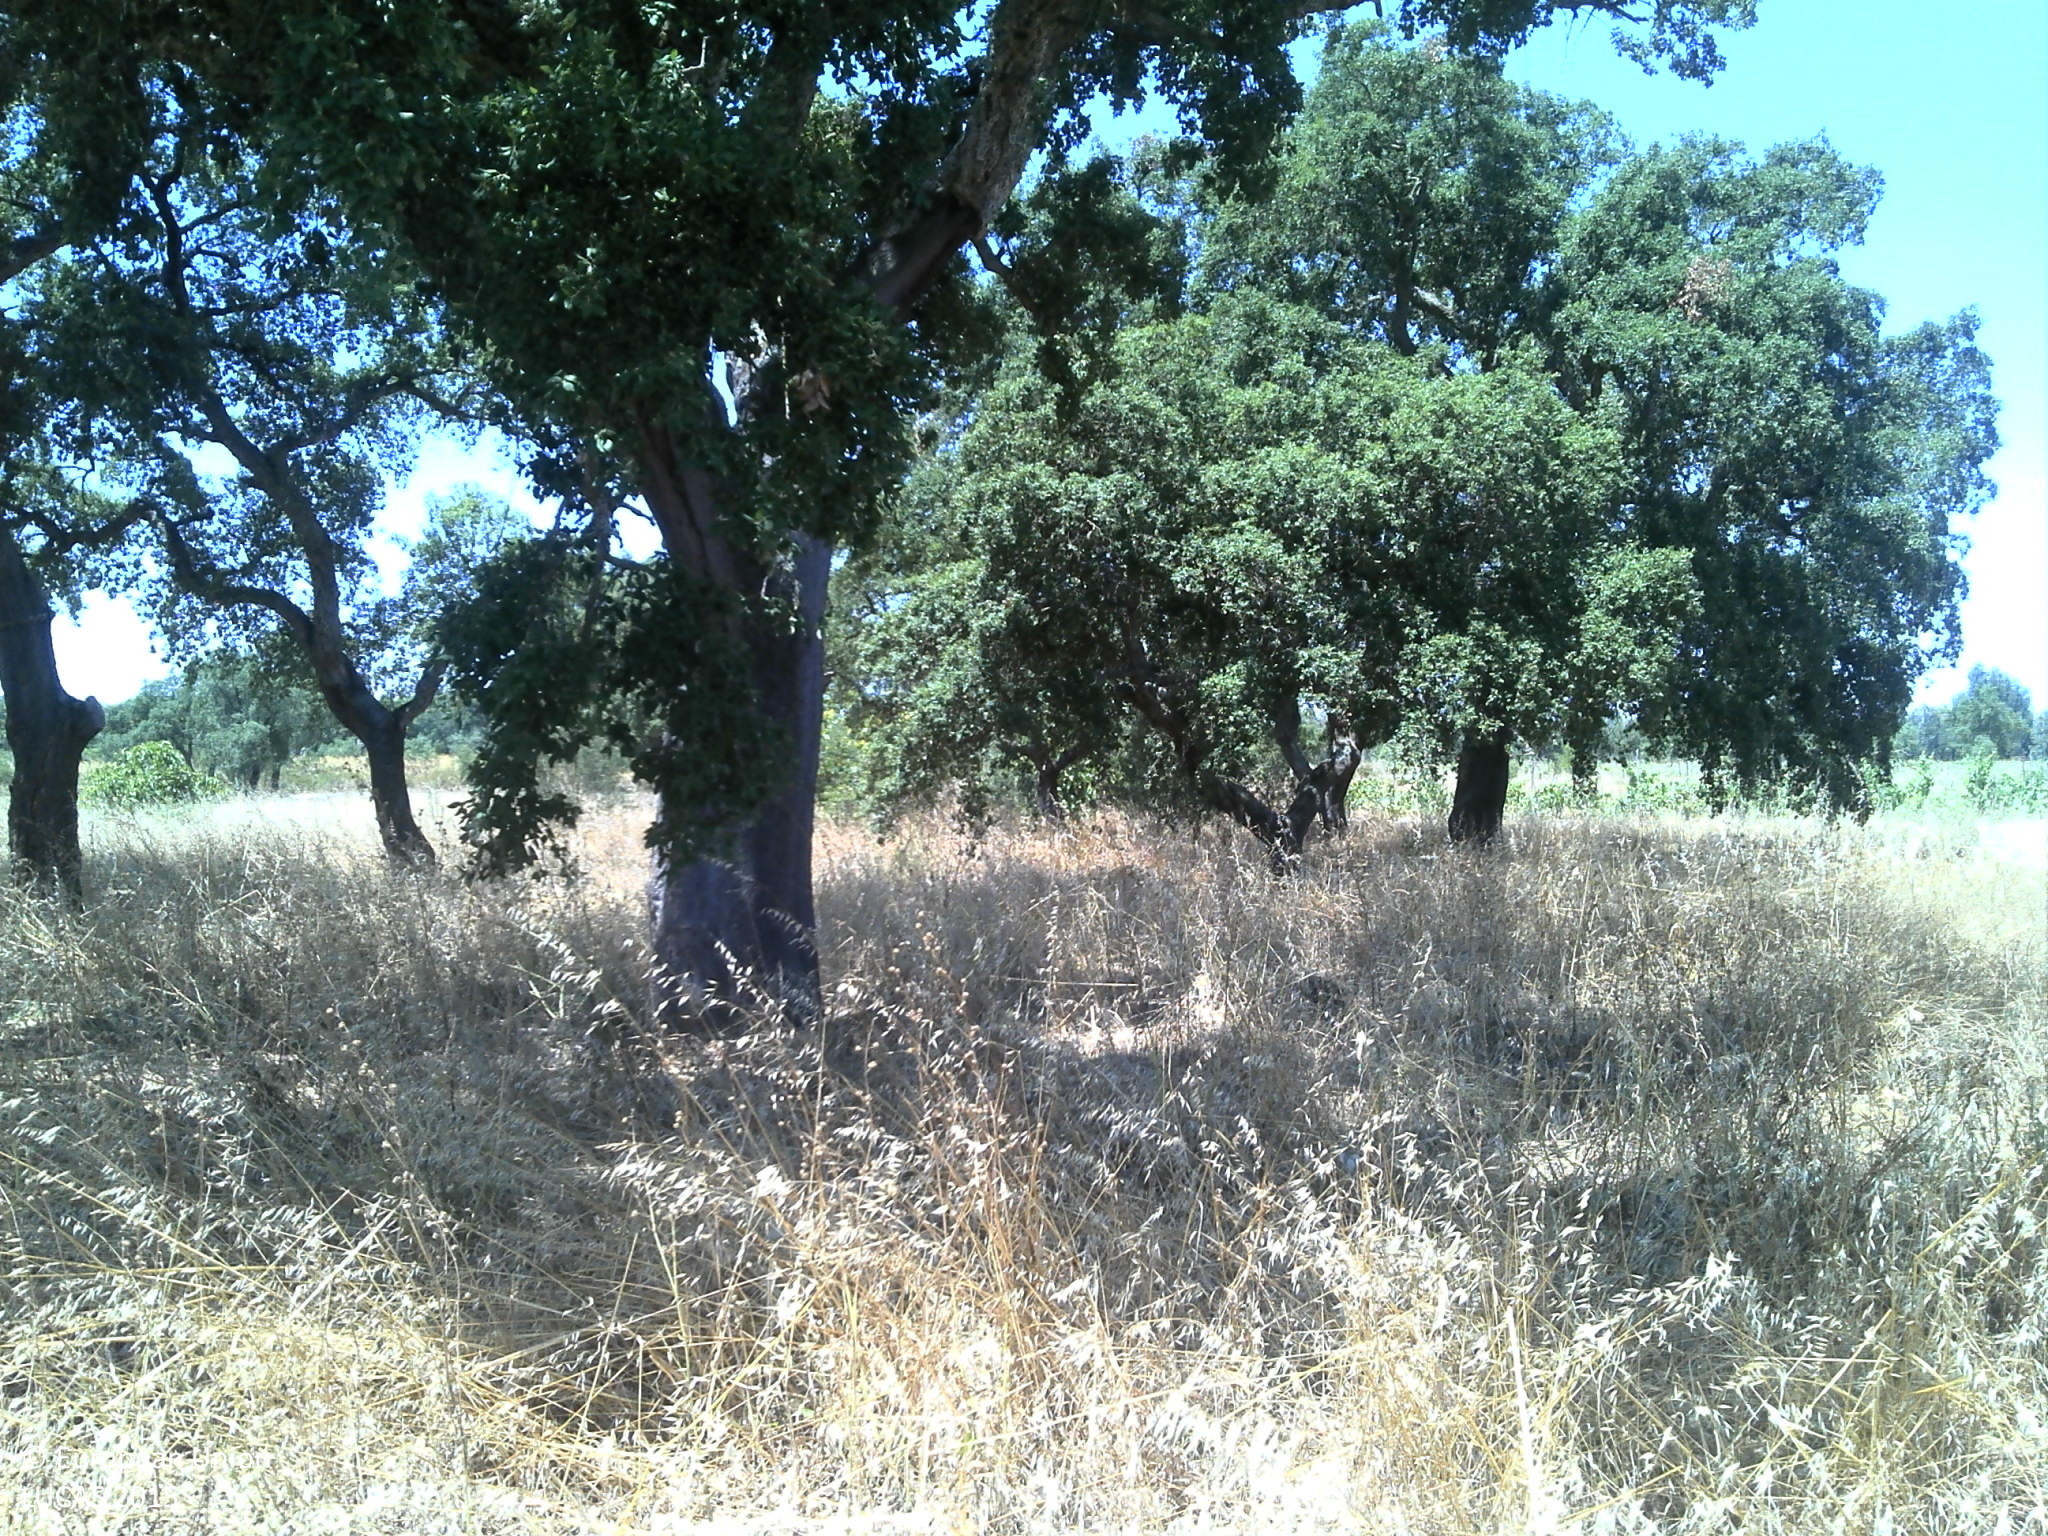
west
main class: Cropland
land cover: Olive groves
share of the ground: 25 - 50 %
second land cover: Grassland without tree/shrub cover
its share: 25 - 50 %
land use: Agriculture (excluding fallow land and kitchen gardens)
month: June
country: PT
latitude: 39.0733
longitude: -8.6430
